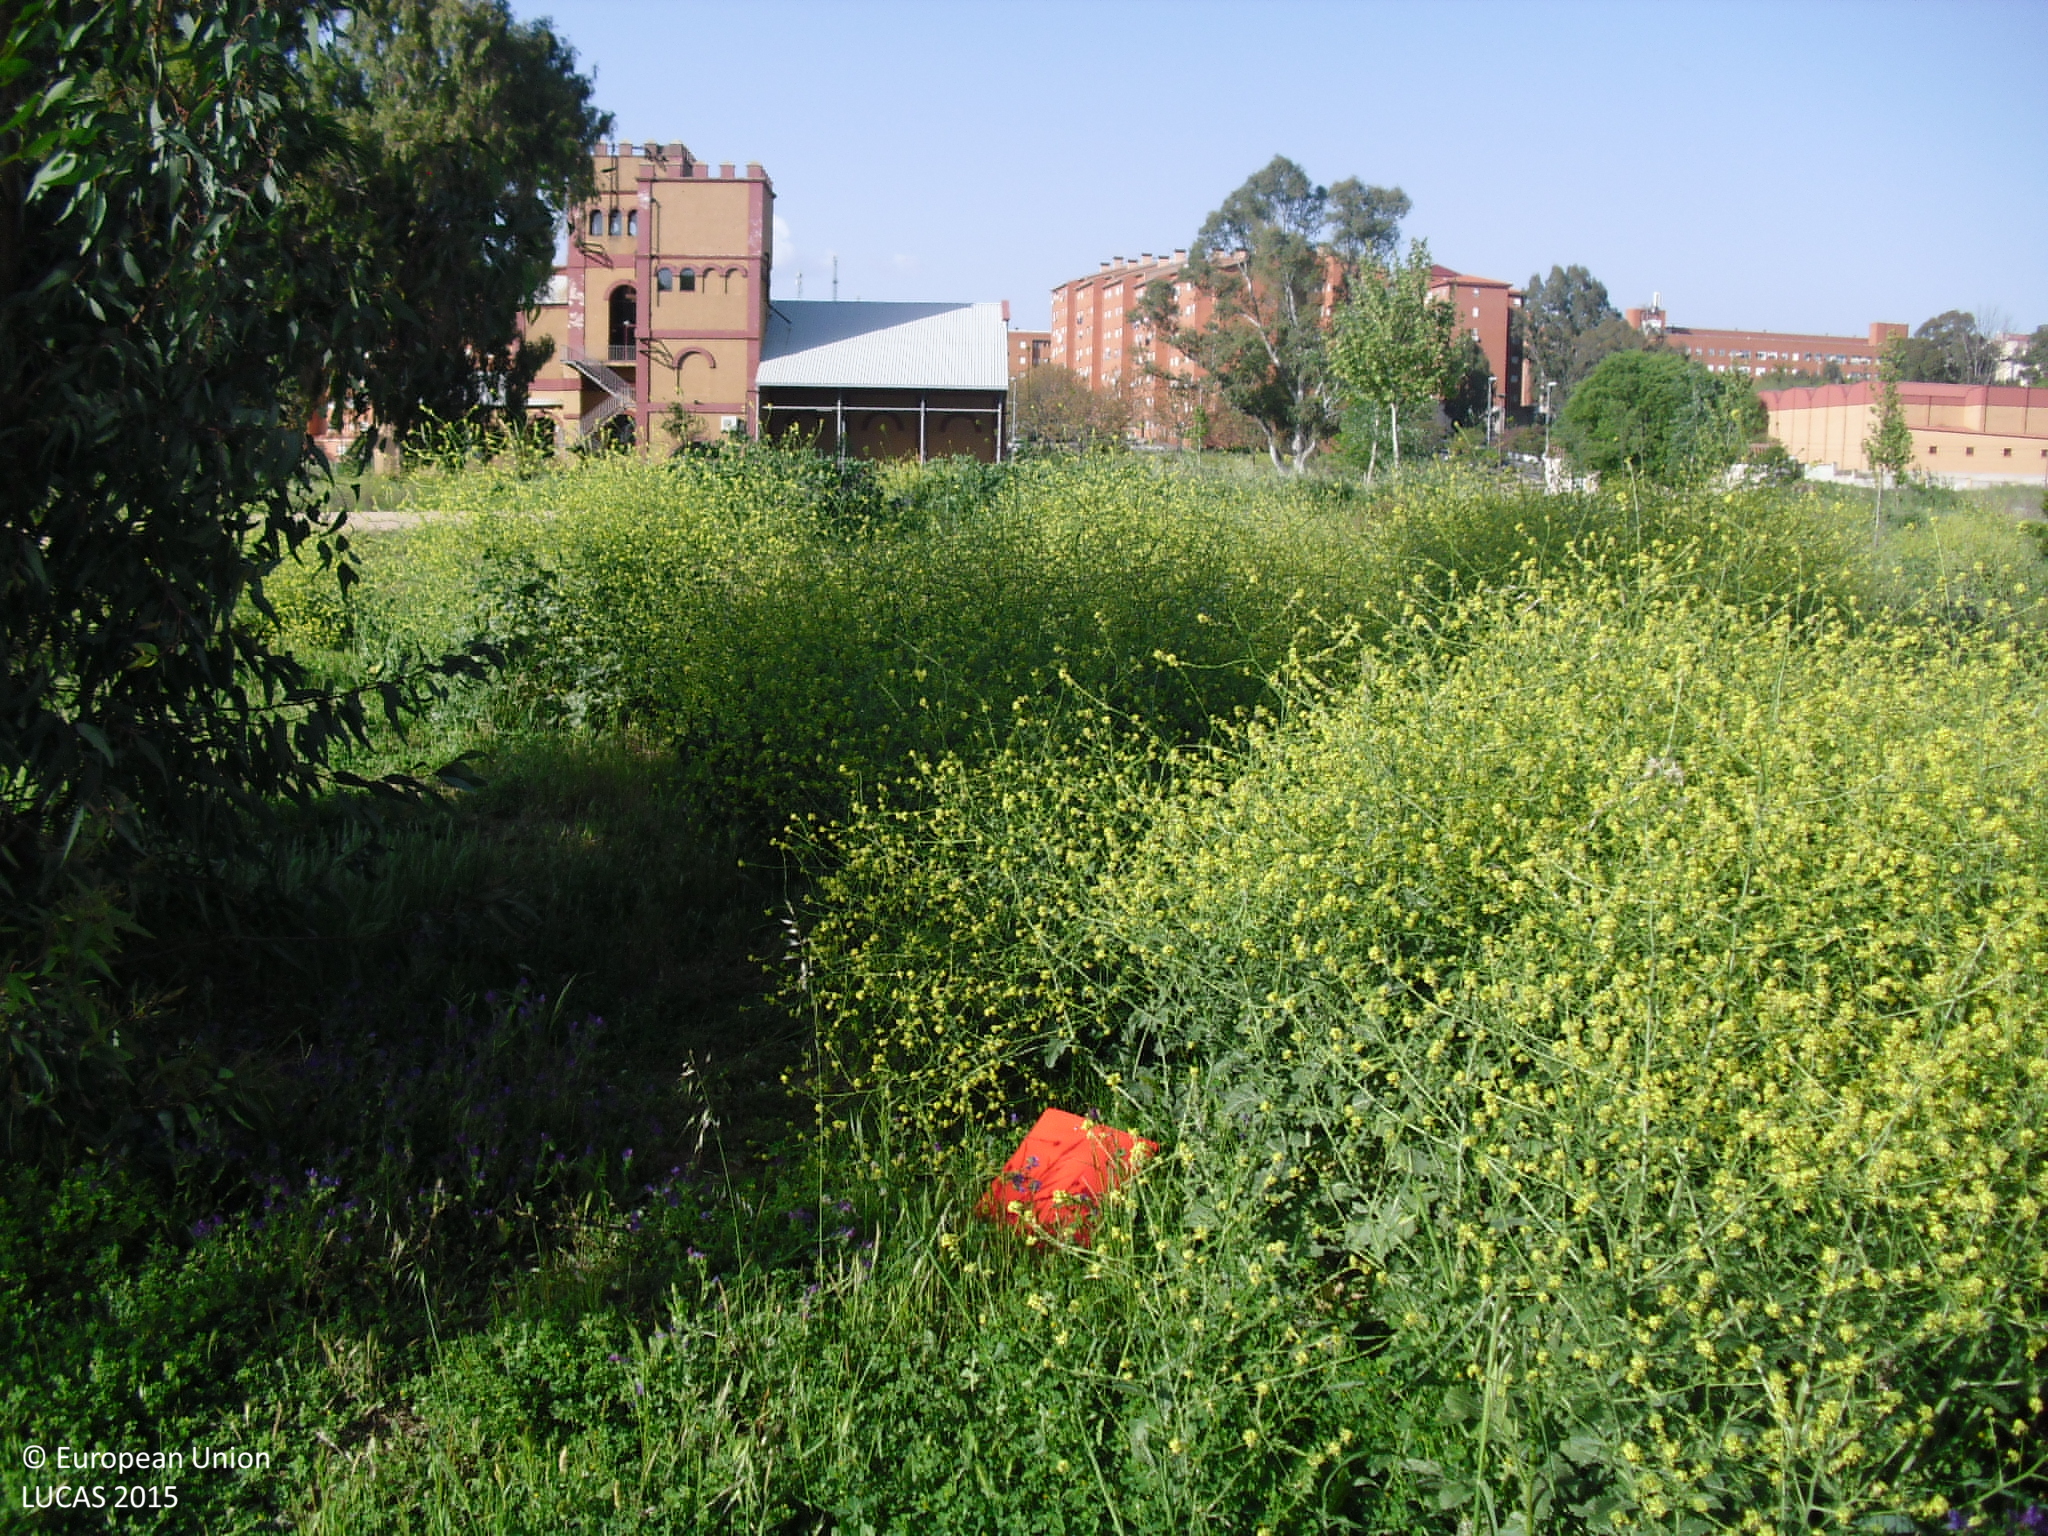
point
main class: Grassland
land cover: Grassland with sparse tree/shrub cover
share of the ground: > 75 %
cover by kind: herbaceous plants 95 %, broadleaved forest trees 5 %
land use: Abandoned areas
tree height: < 5 m
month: April
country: ES
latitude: 39.4486
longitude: -6.3946
